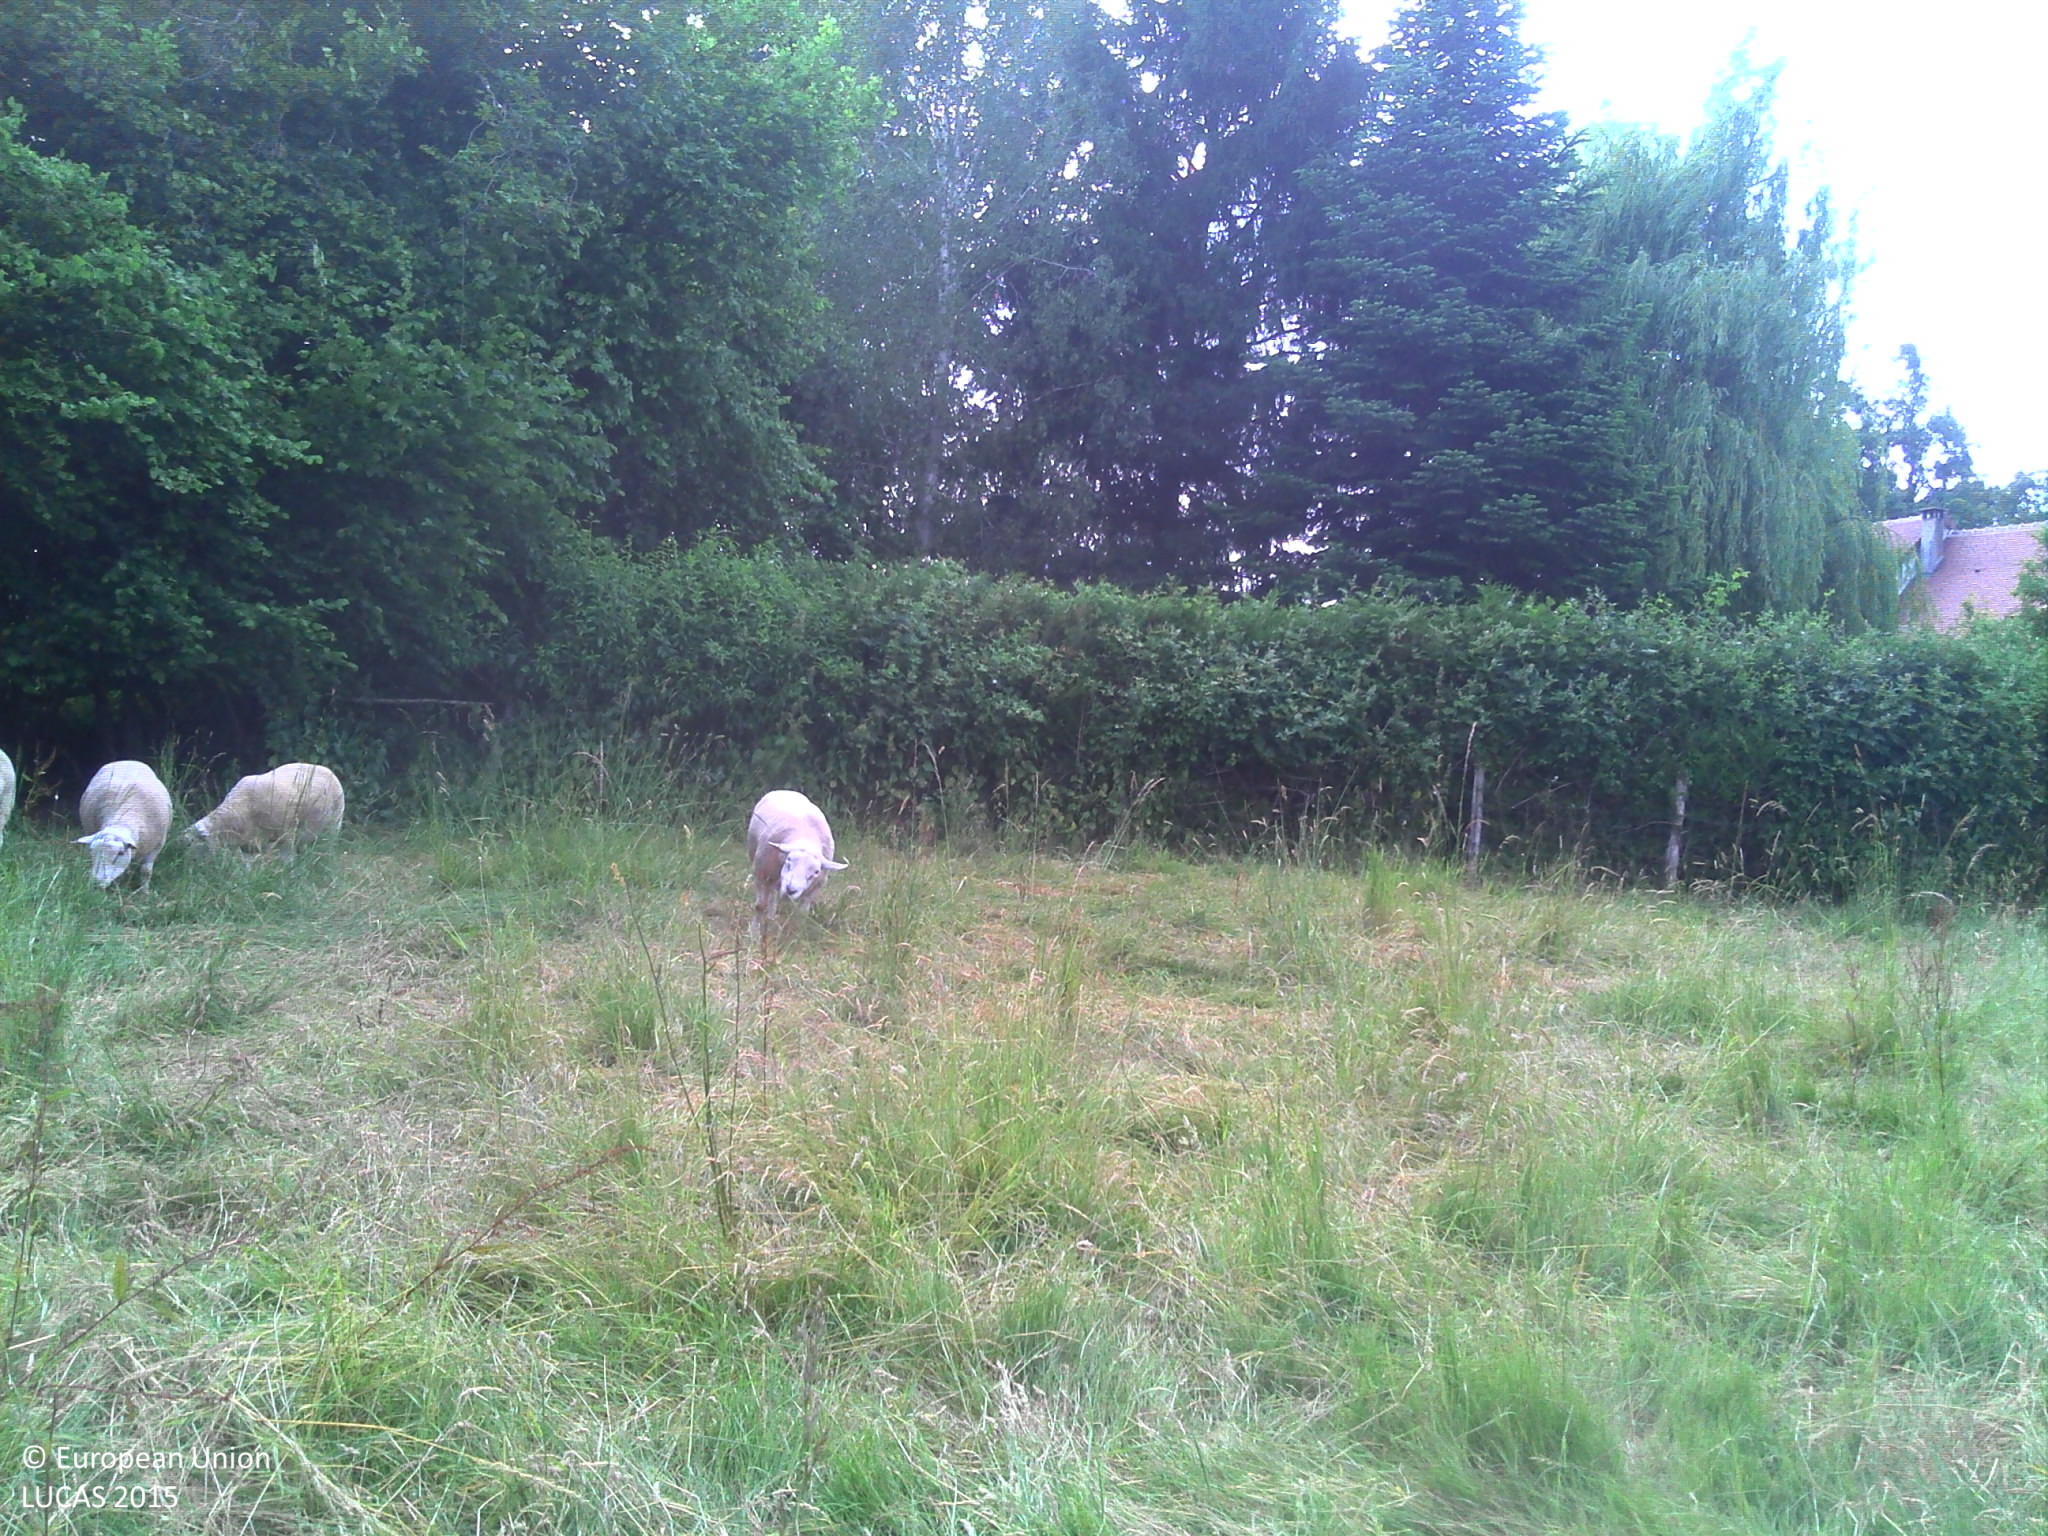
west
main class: Grassland
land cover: Grassland without tree/shrub cover
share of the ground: > 75 %
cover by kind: herbaceous plants 100 %
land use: Agriculture (excluding fallow land and kitchen gardens)
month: June
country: FR
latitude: 47.2202
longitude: 3.2216
